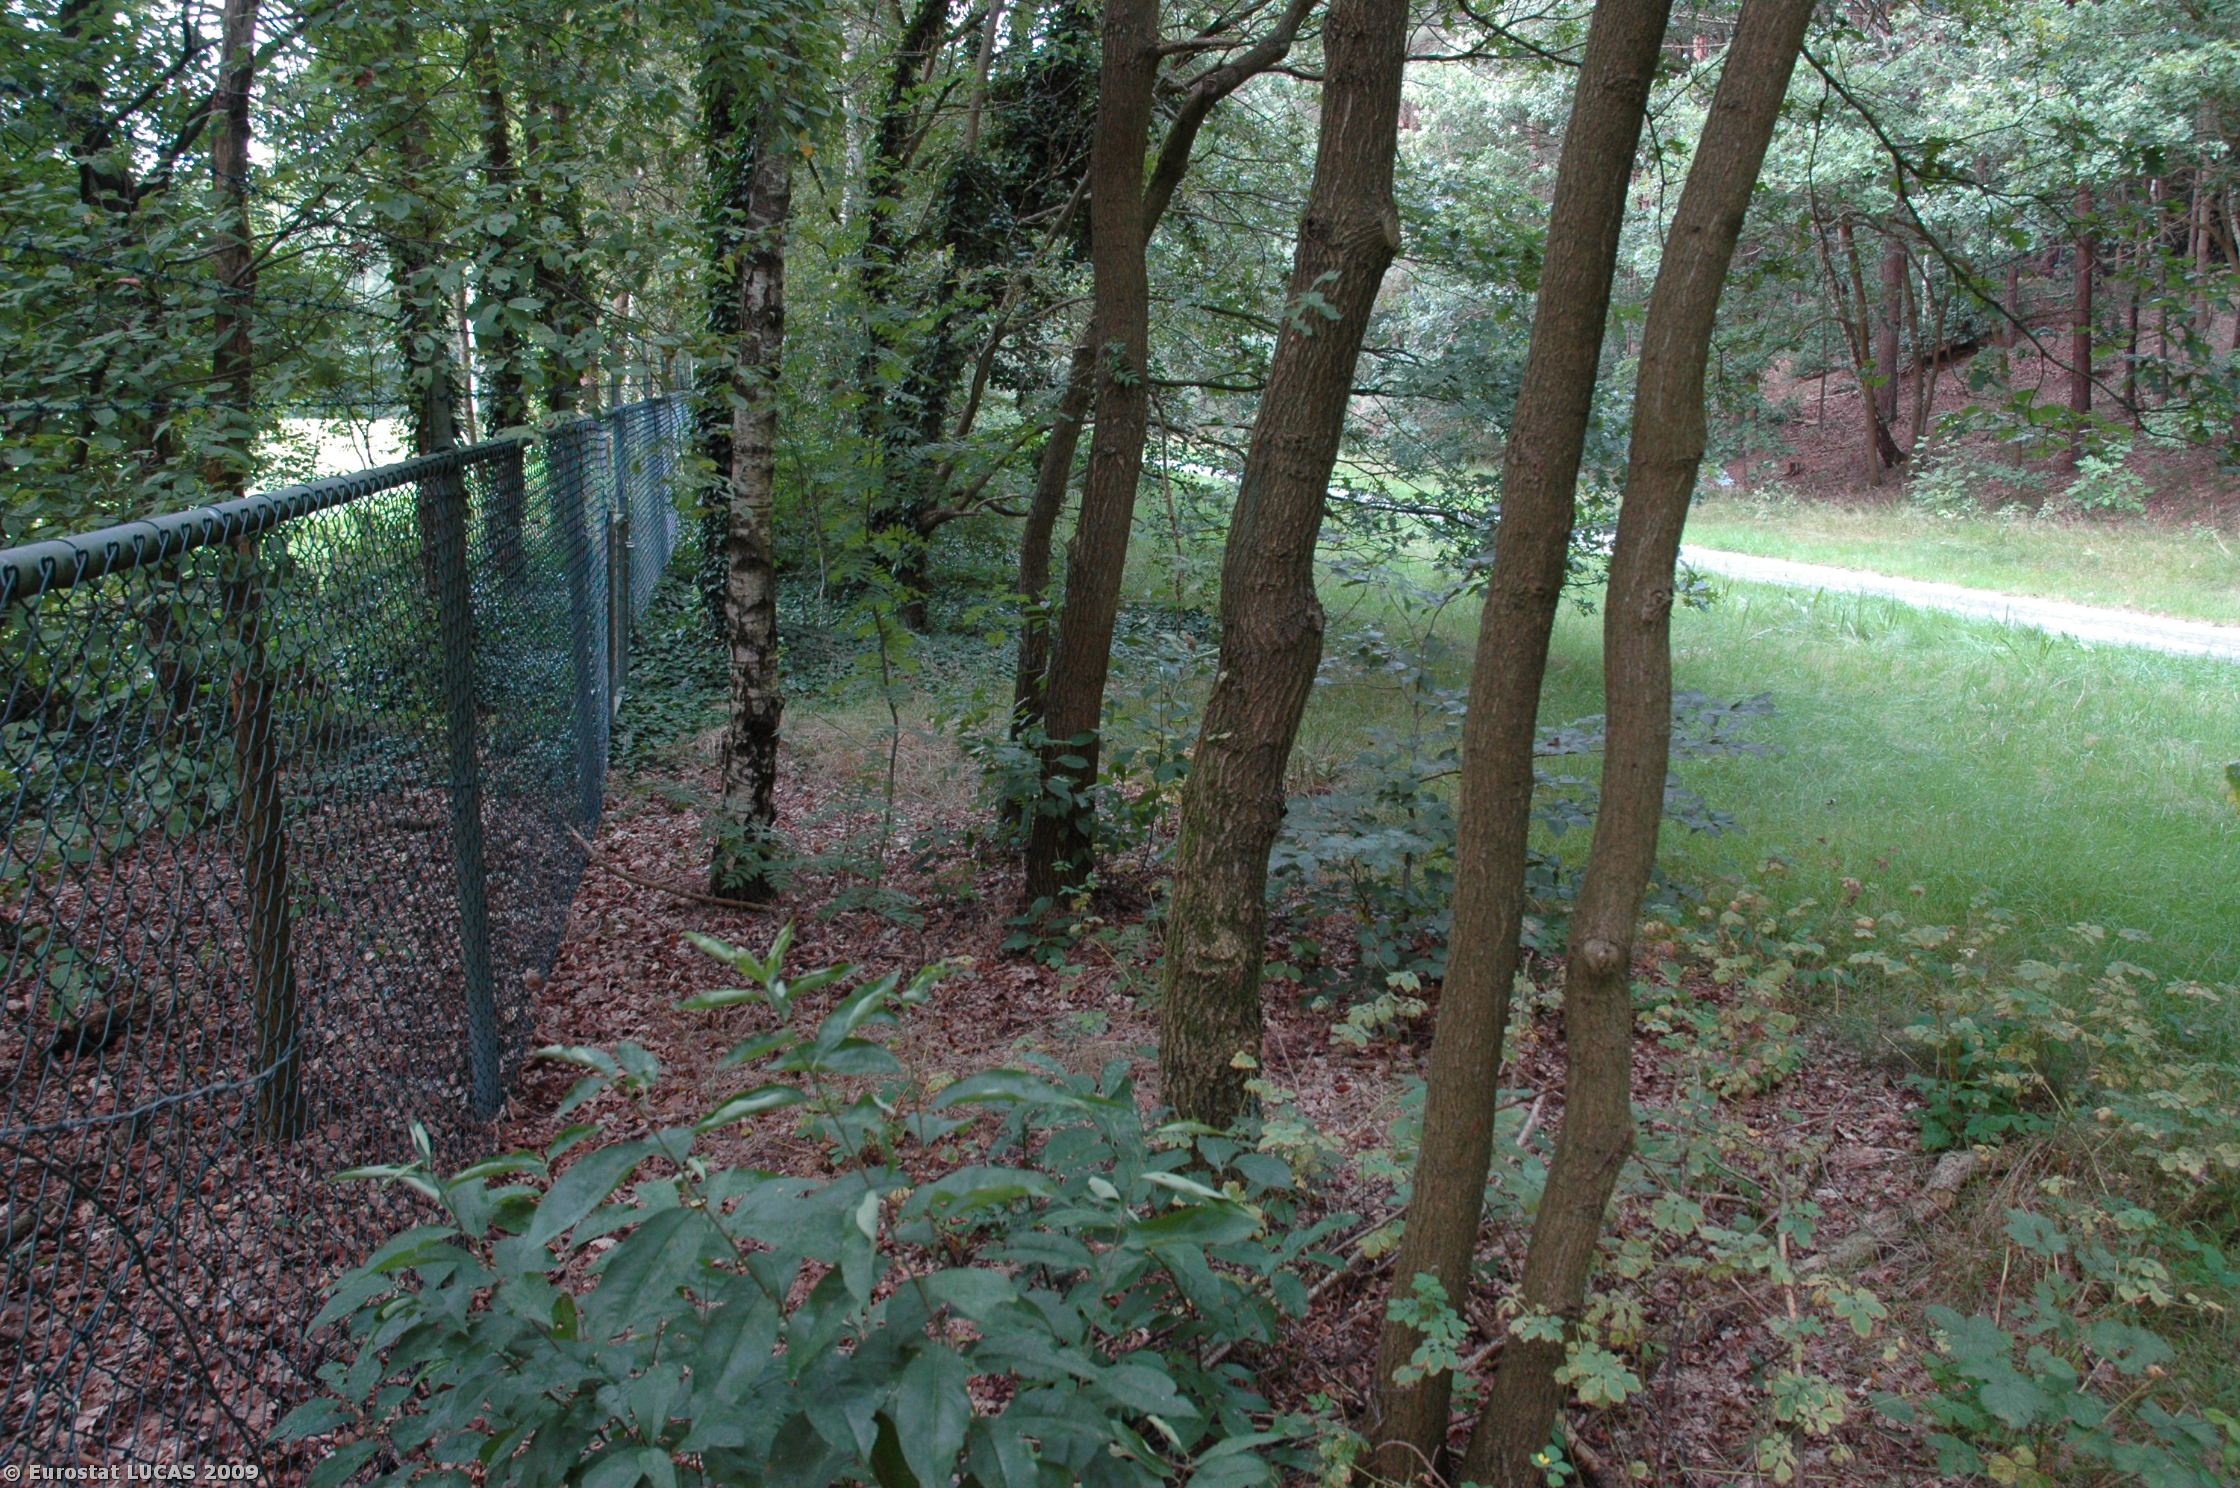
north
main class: Woodland
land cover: Broadleaved woodland
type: plantations and self-sown exotic forest
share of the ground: > 75 %
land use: Amenities, museums, leisure
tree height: > 5 m
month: August
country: NL
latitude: 52.4564
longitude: 6.0701
